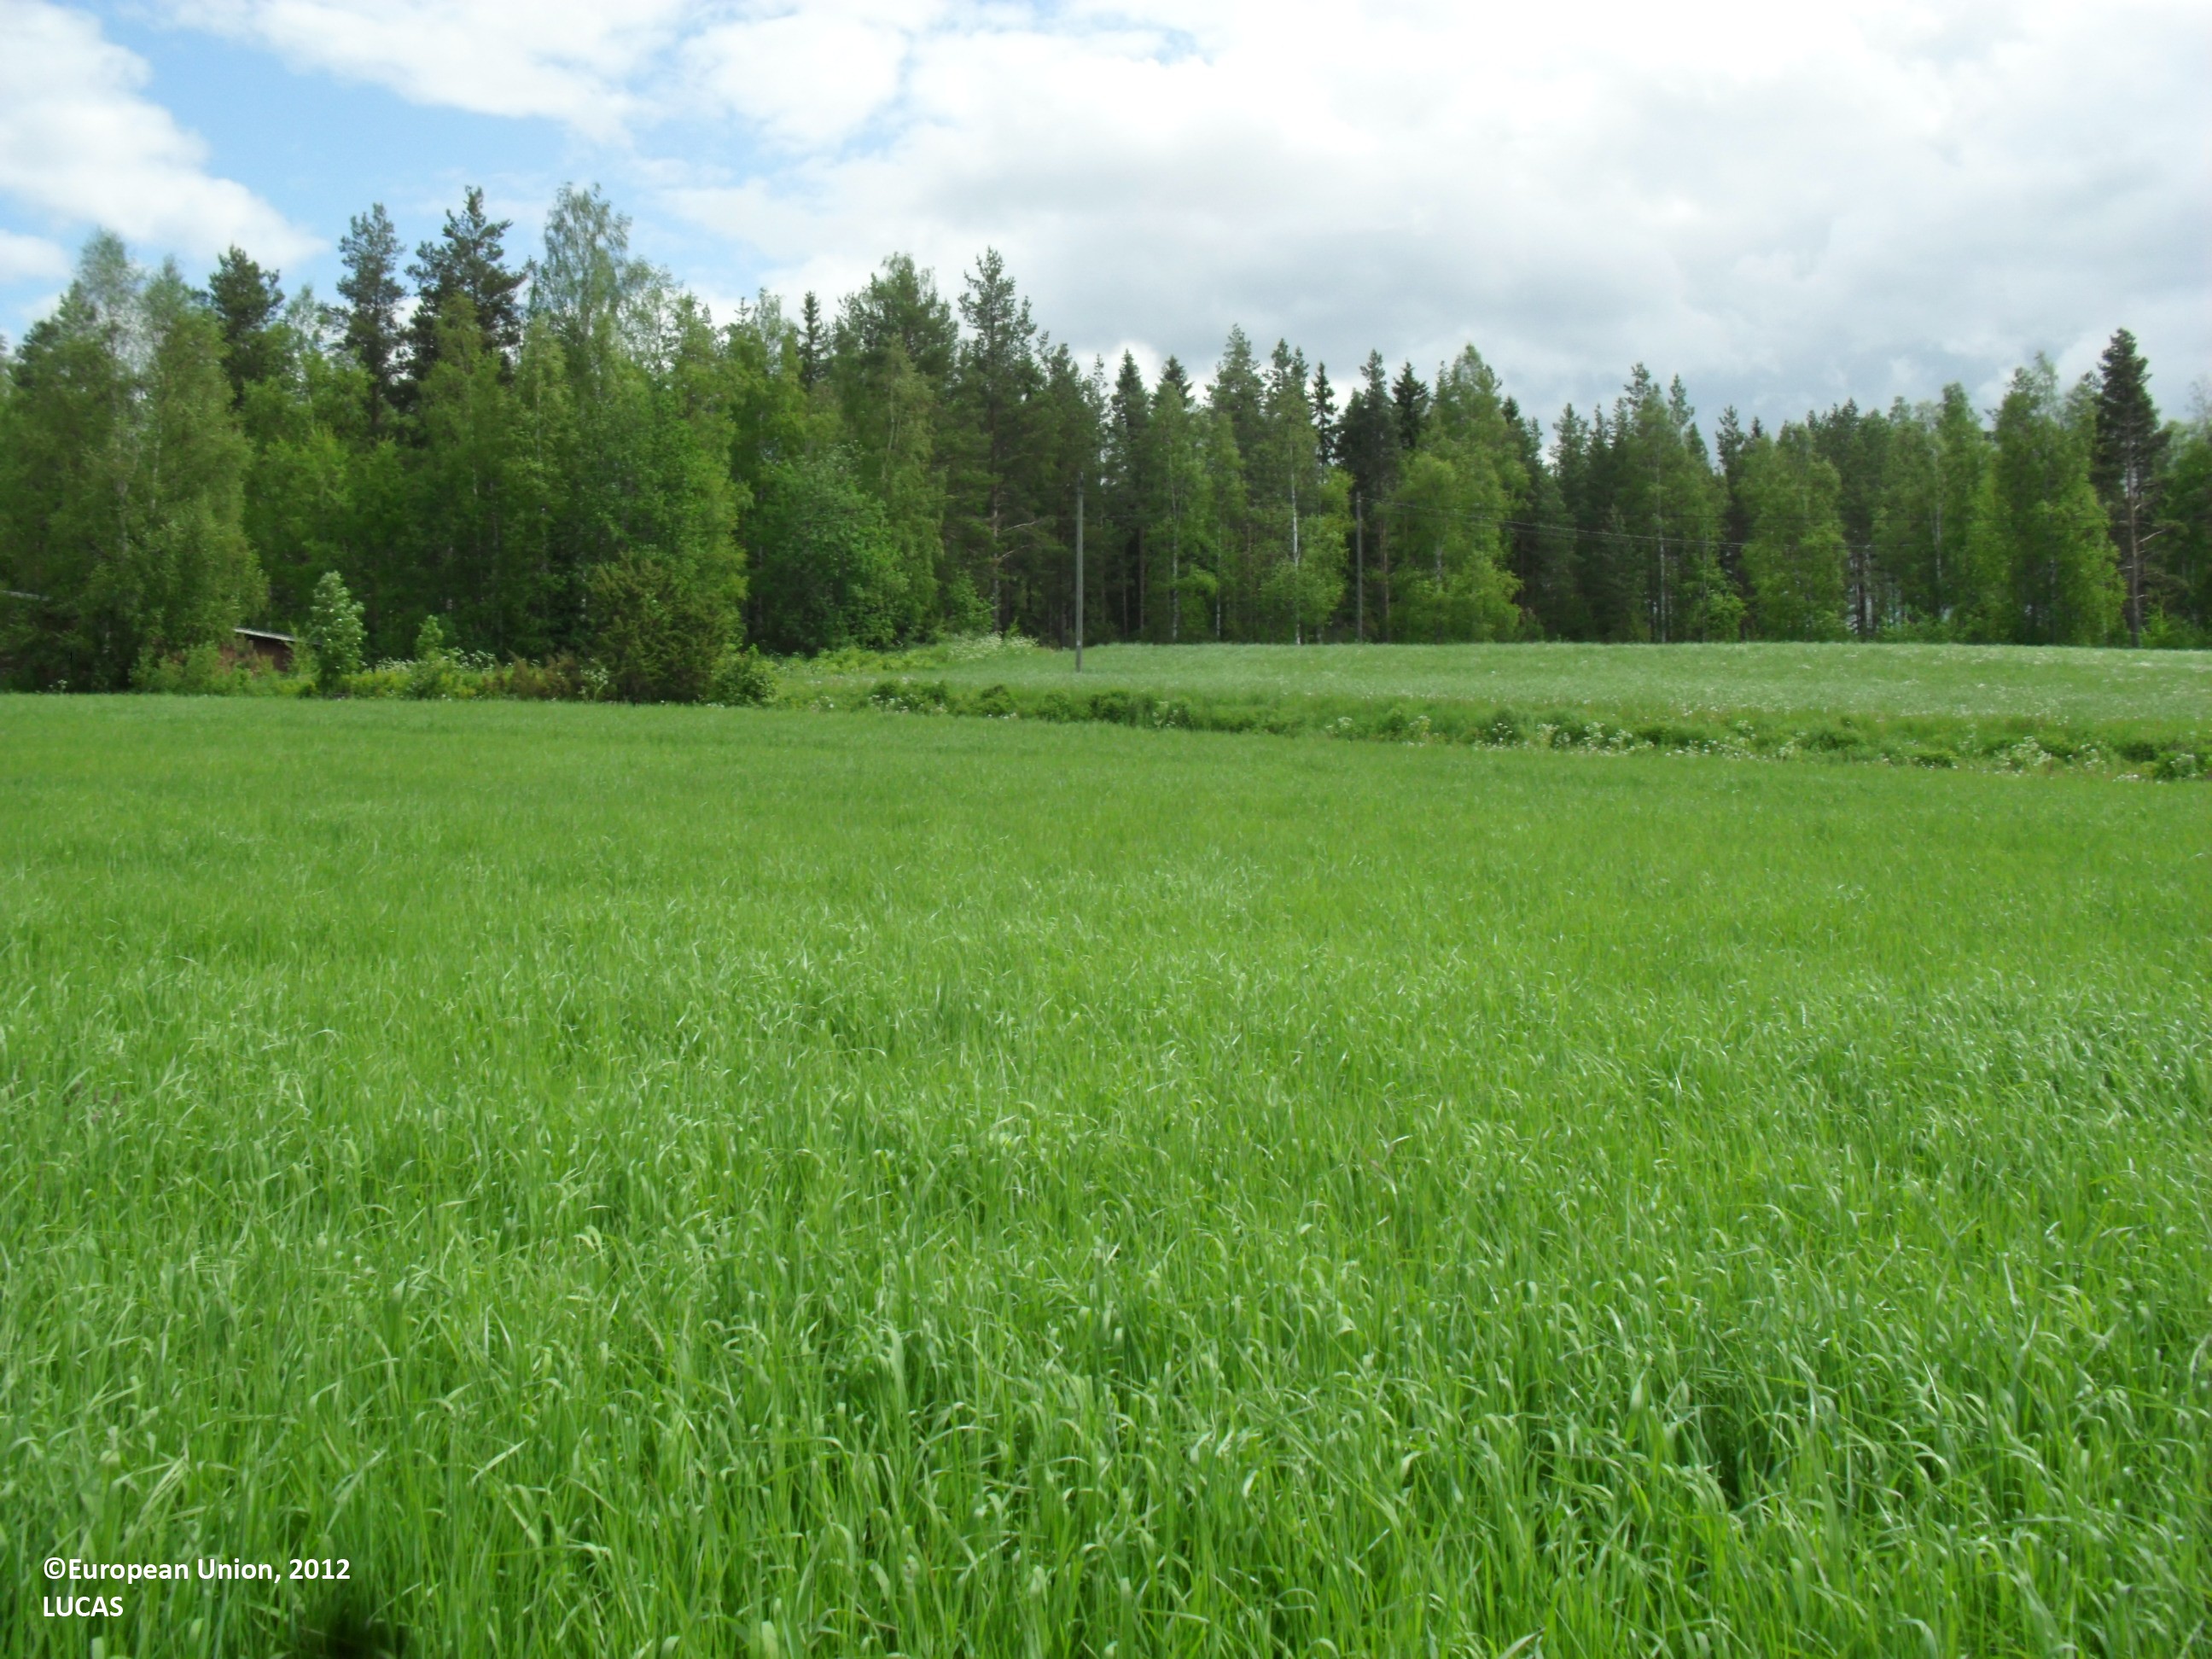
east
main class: Cropland
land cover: Temporary grasslands
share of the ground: > 75 %
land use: Agriculture (excluding fallow land and kitchen gardens)
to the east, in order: Temporary grasslands; Ditches and canals; Grass margins; Paved roads, cycling and walking lanes; Grass margins; Ditches and canals; Temporary grasslands; Other mixed woodland; Grass margins; Ditches and canals; Pine dominated mixed woodland; Other mixed woodland; Paved roads, cycling and walking lanes; Other mixed woodland; Paved roads, cycling and walking lanes; Other mixed woodland; Grass margins; Ditches and canals; Grass margins; Paved roads, cycling and walking lanes; Grass margins; Ditches and canals; Other bare soil
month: June
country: FI
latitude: 62.7512
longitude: 23.5188
